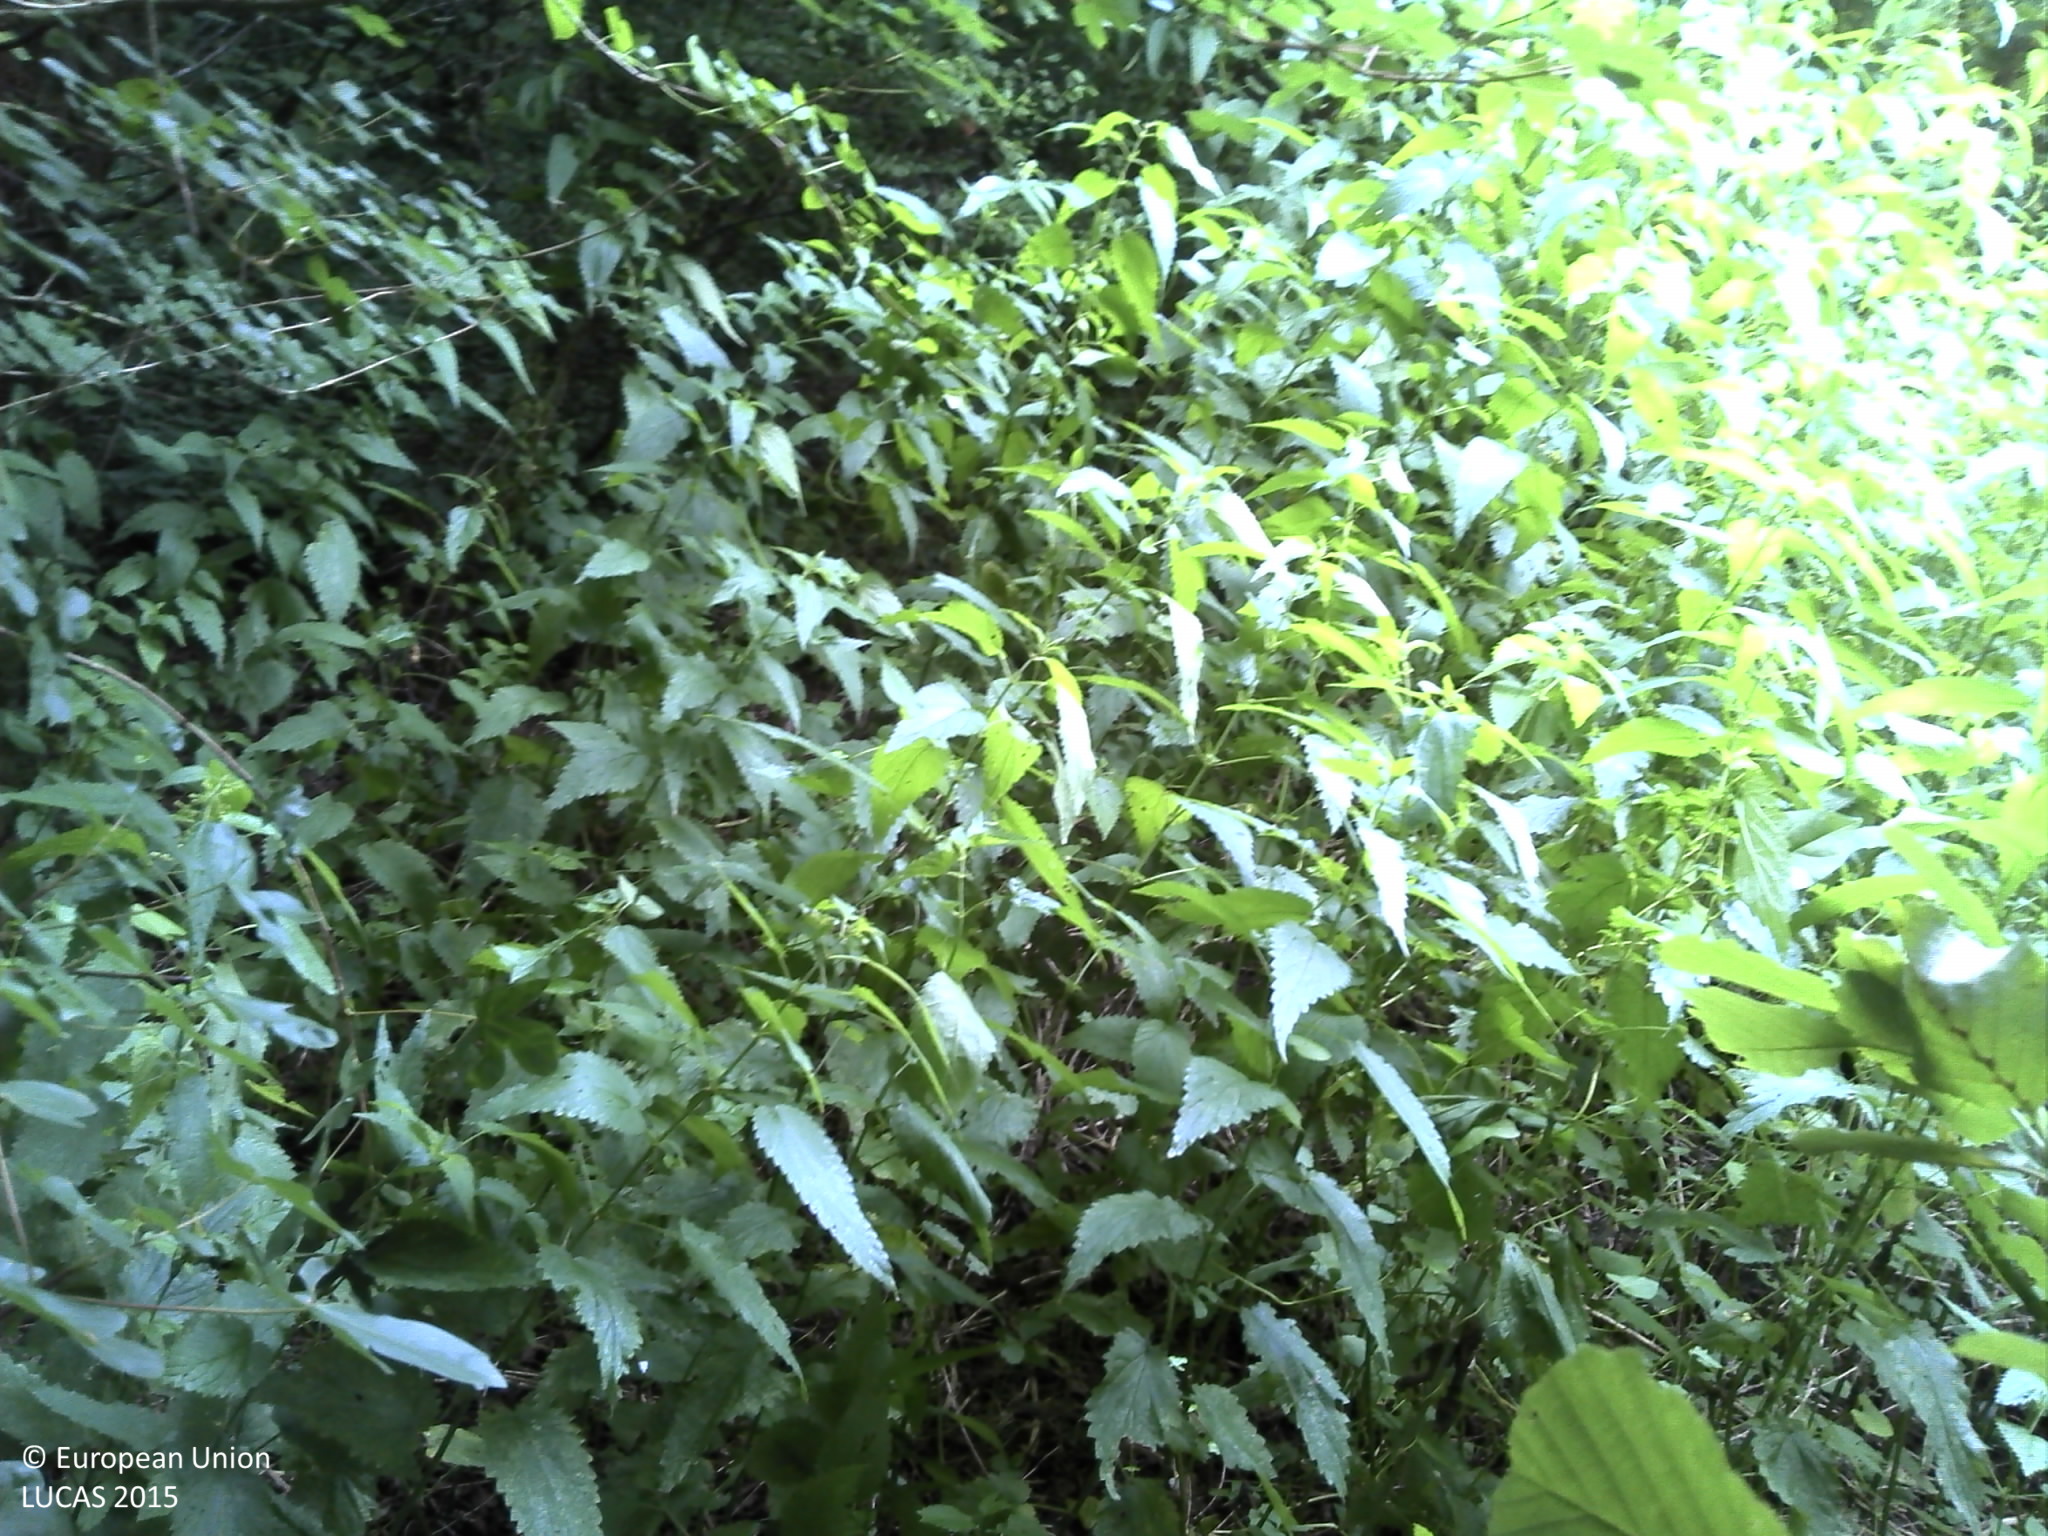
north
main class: Woodland
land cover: Broadleaved woodland
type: acidophilous oak and oak-birch forest
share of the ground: > 75 %
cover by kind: broadleaved forest trees 100 %
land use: Forestry
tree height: > 5 m
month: June
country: HR
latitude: 45.3122
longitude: 17.2065
